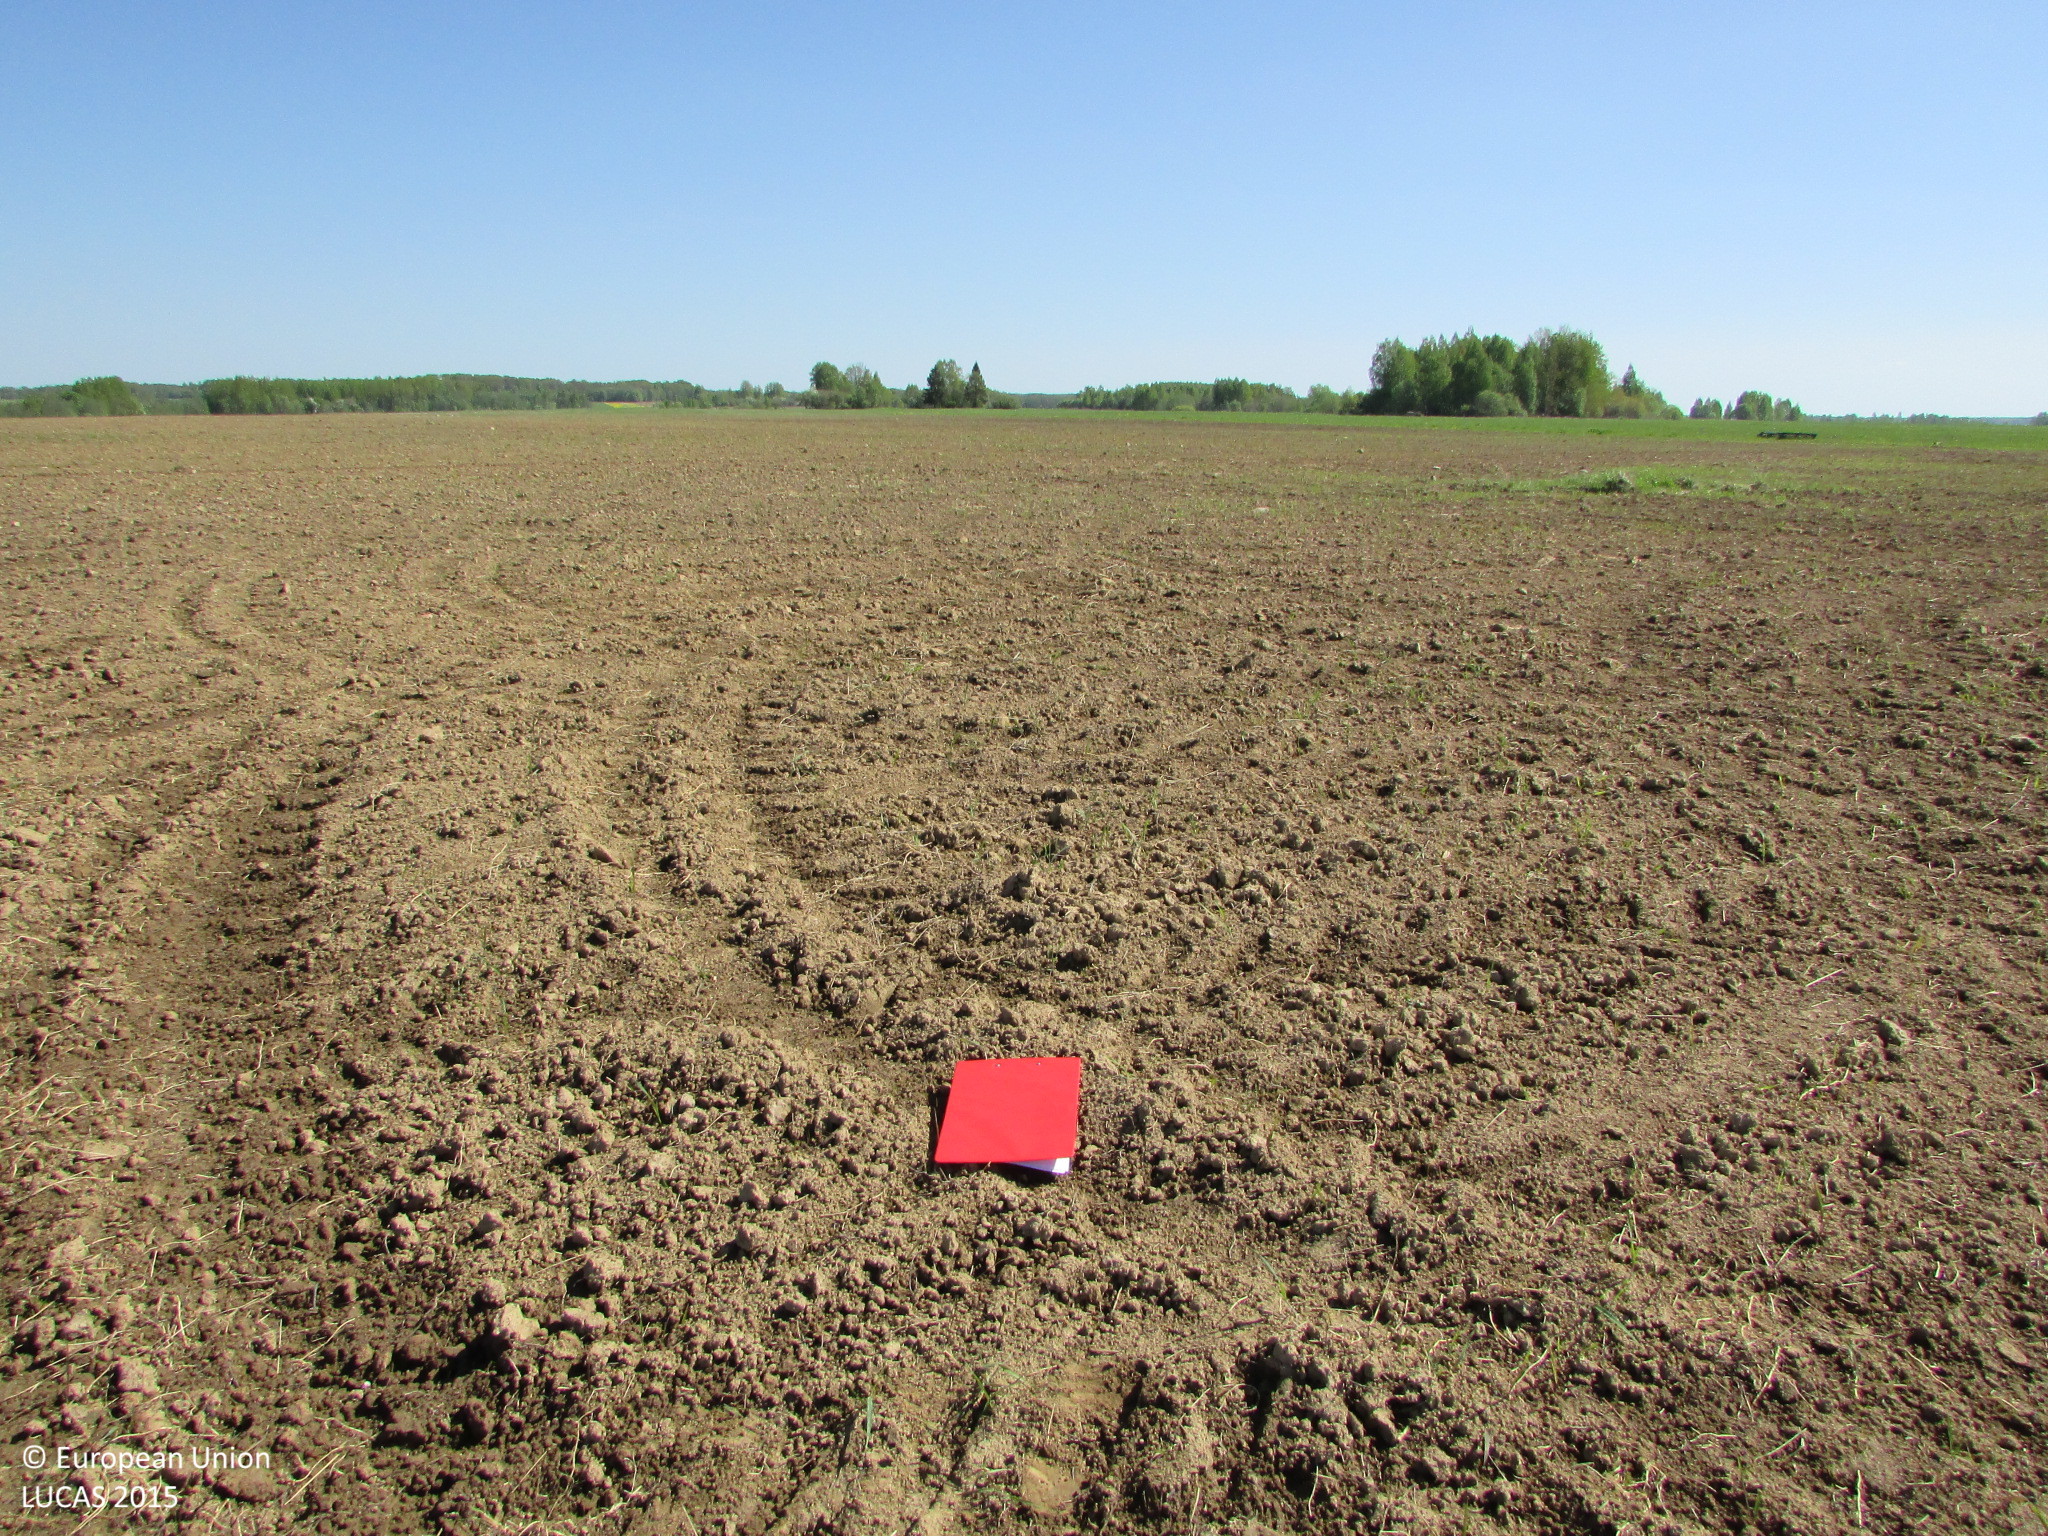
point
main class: Cropland
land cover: Oats
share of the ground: < 10 %
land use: Agriculture (excluding fallow land and kitchen gardens)
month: May
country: LV
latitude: 55.8064
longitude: 27.4604
